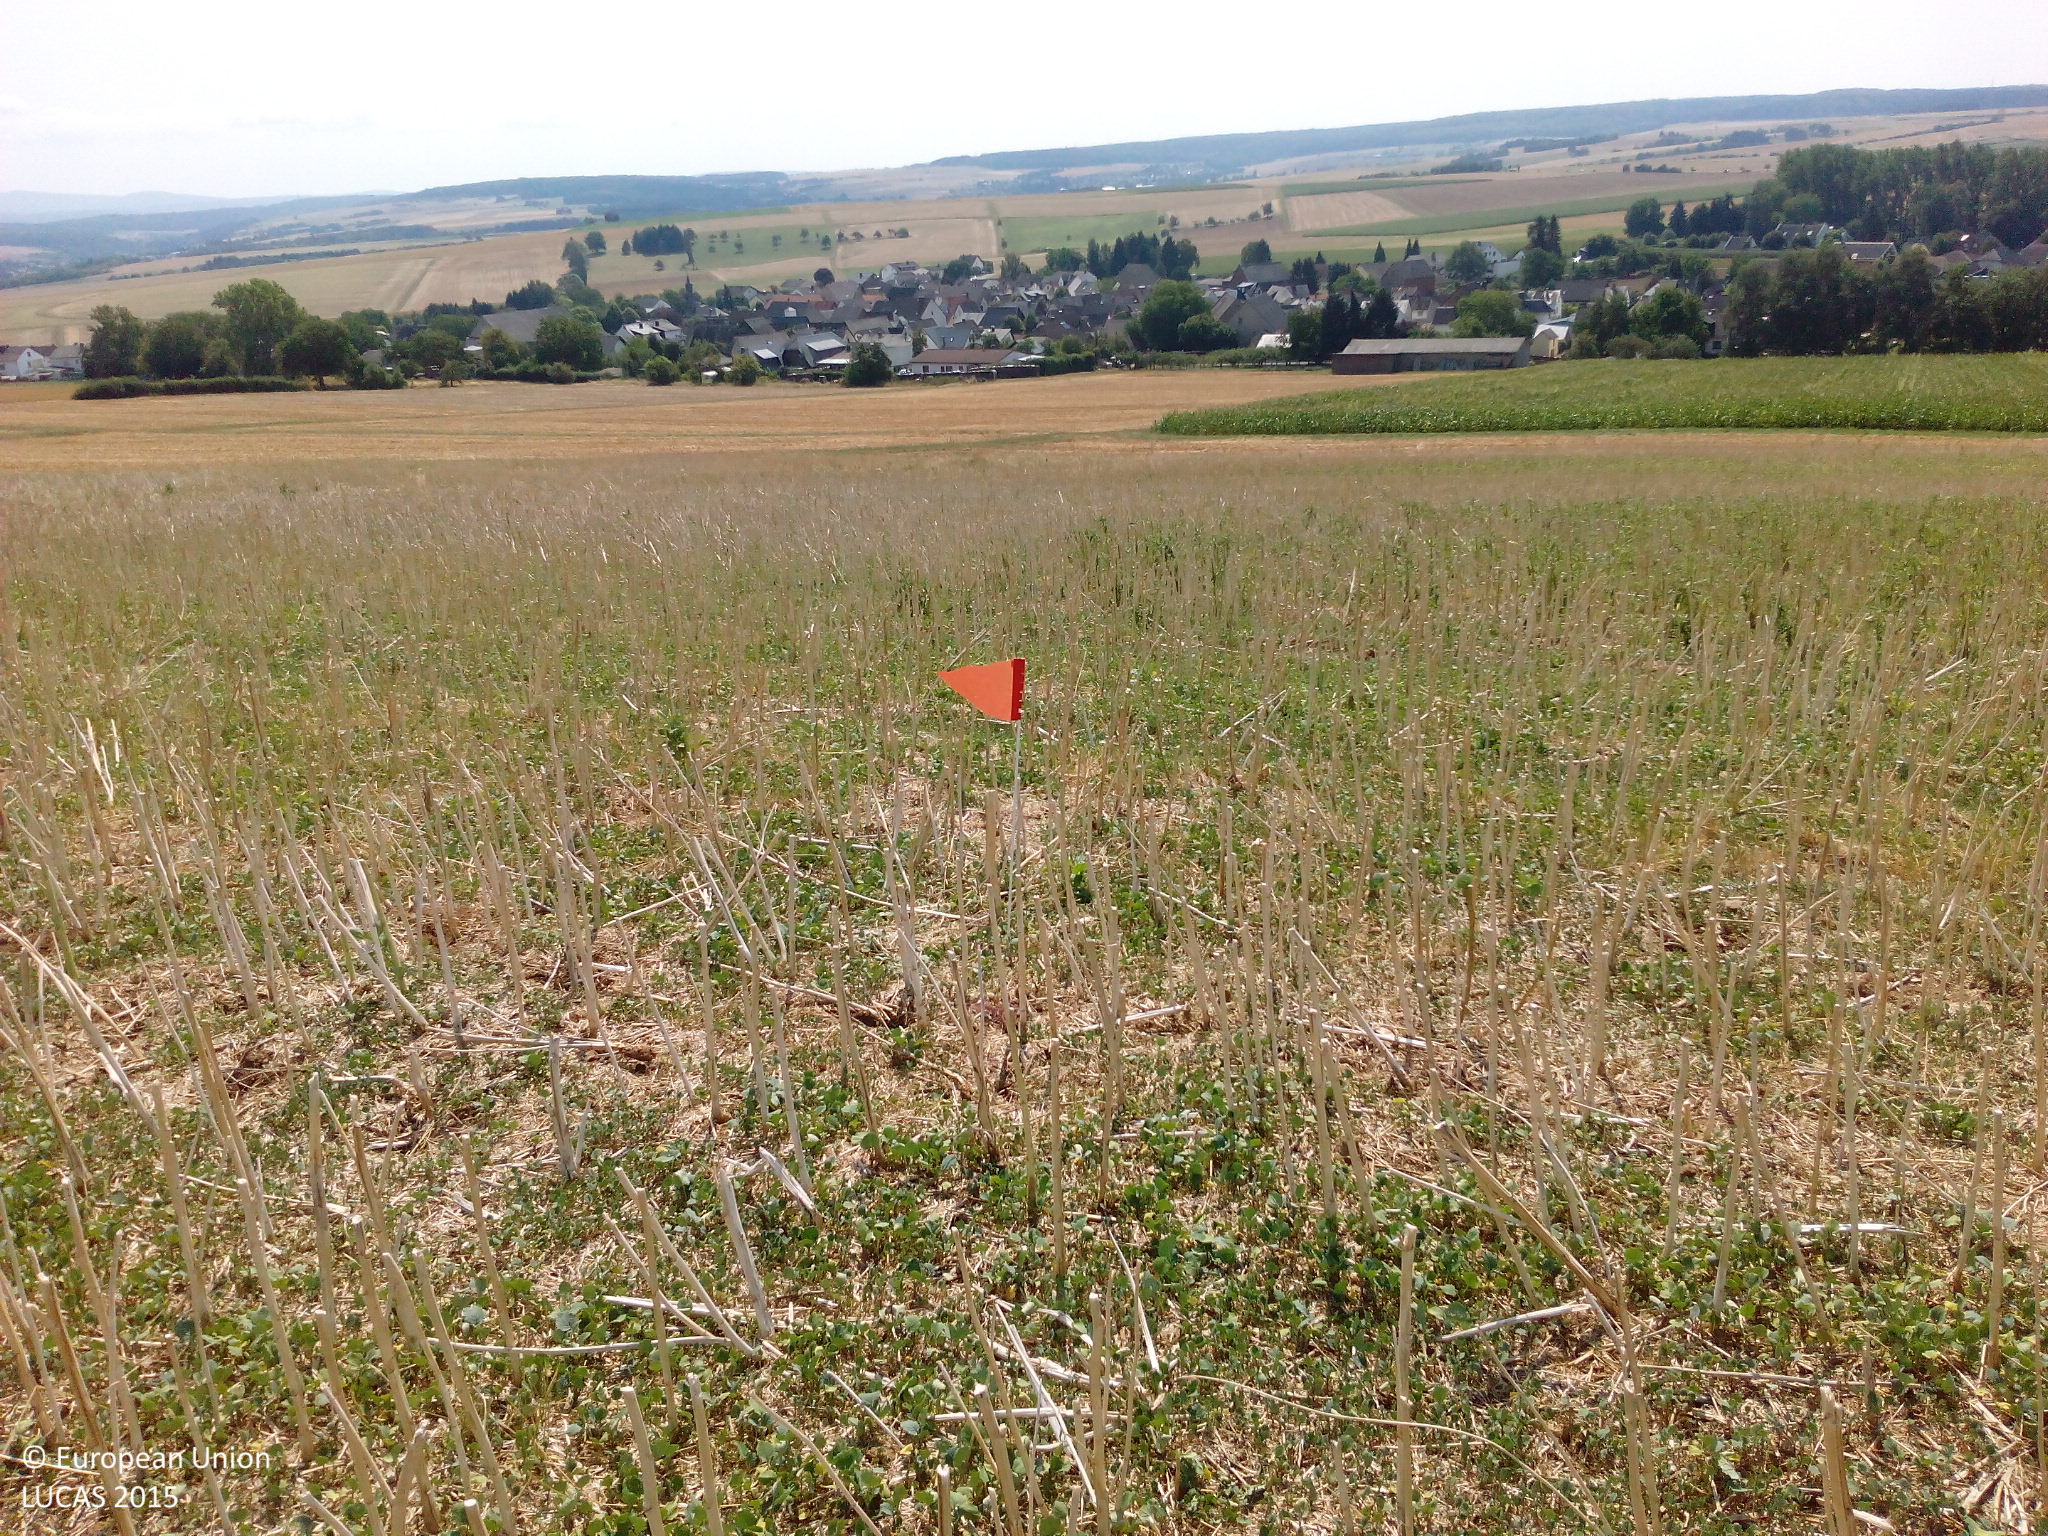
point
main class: Cropland
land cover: Rape and turnip rape
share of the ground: < 10 %
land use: Agriculture (excluding fallow land and kitchen gardens)
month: August
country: DE
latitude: 50.3488
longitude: 8.1313
